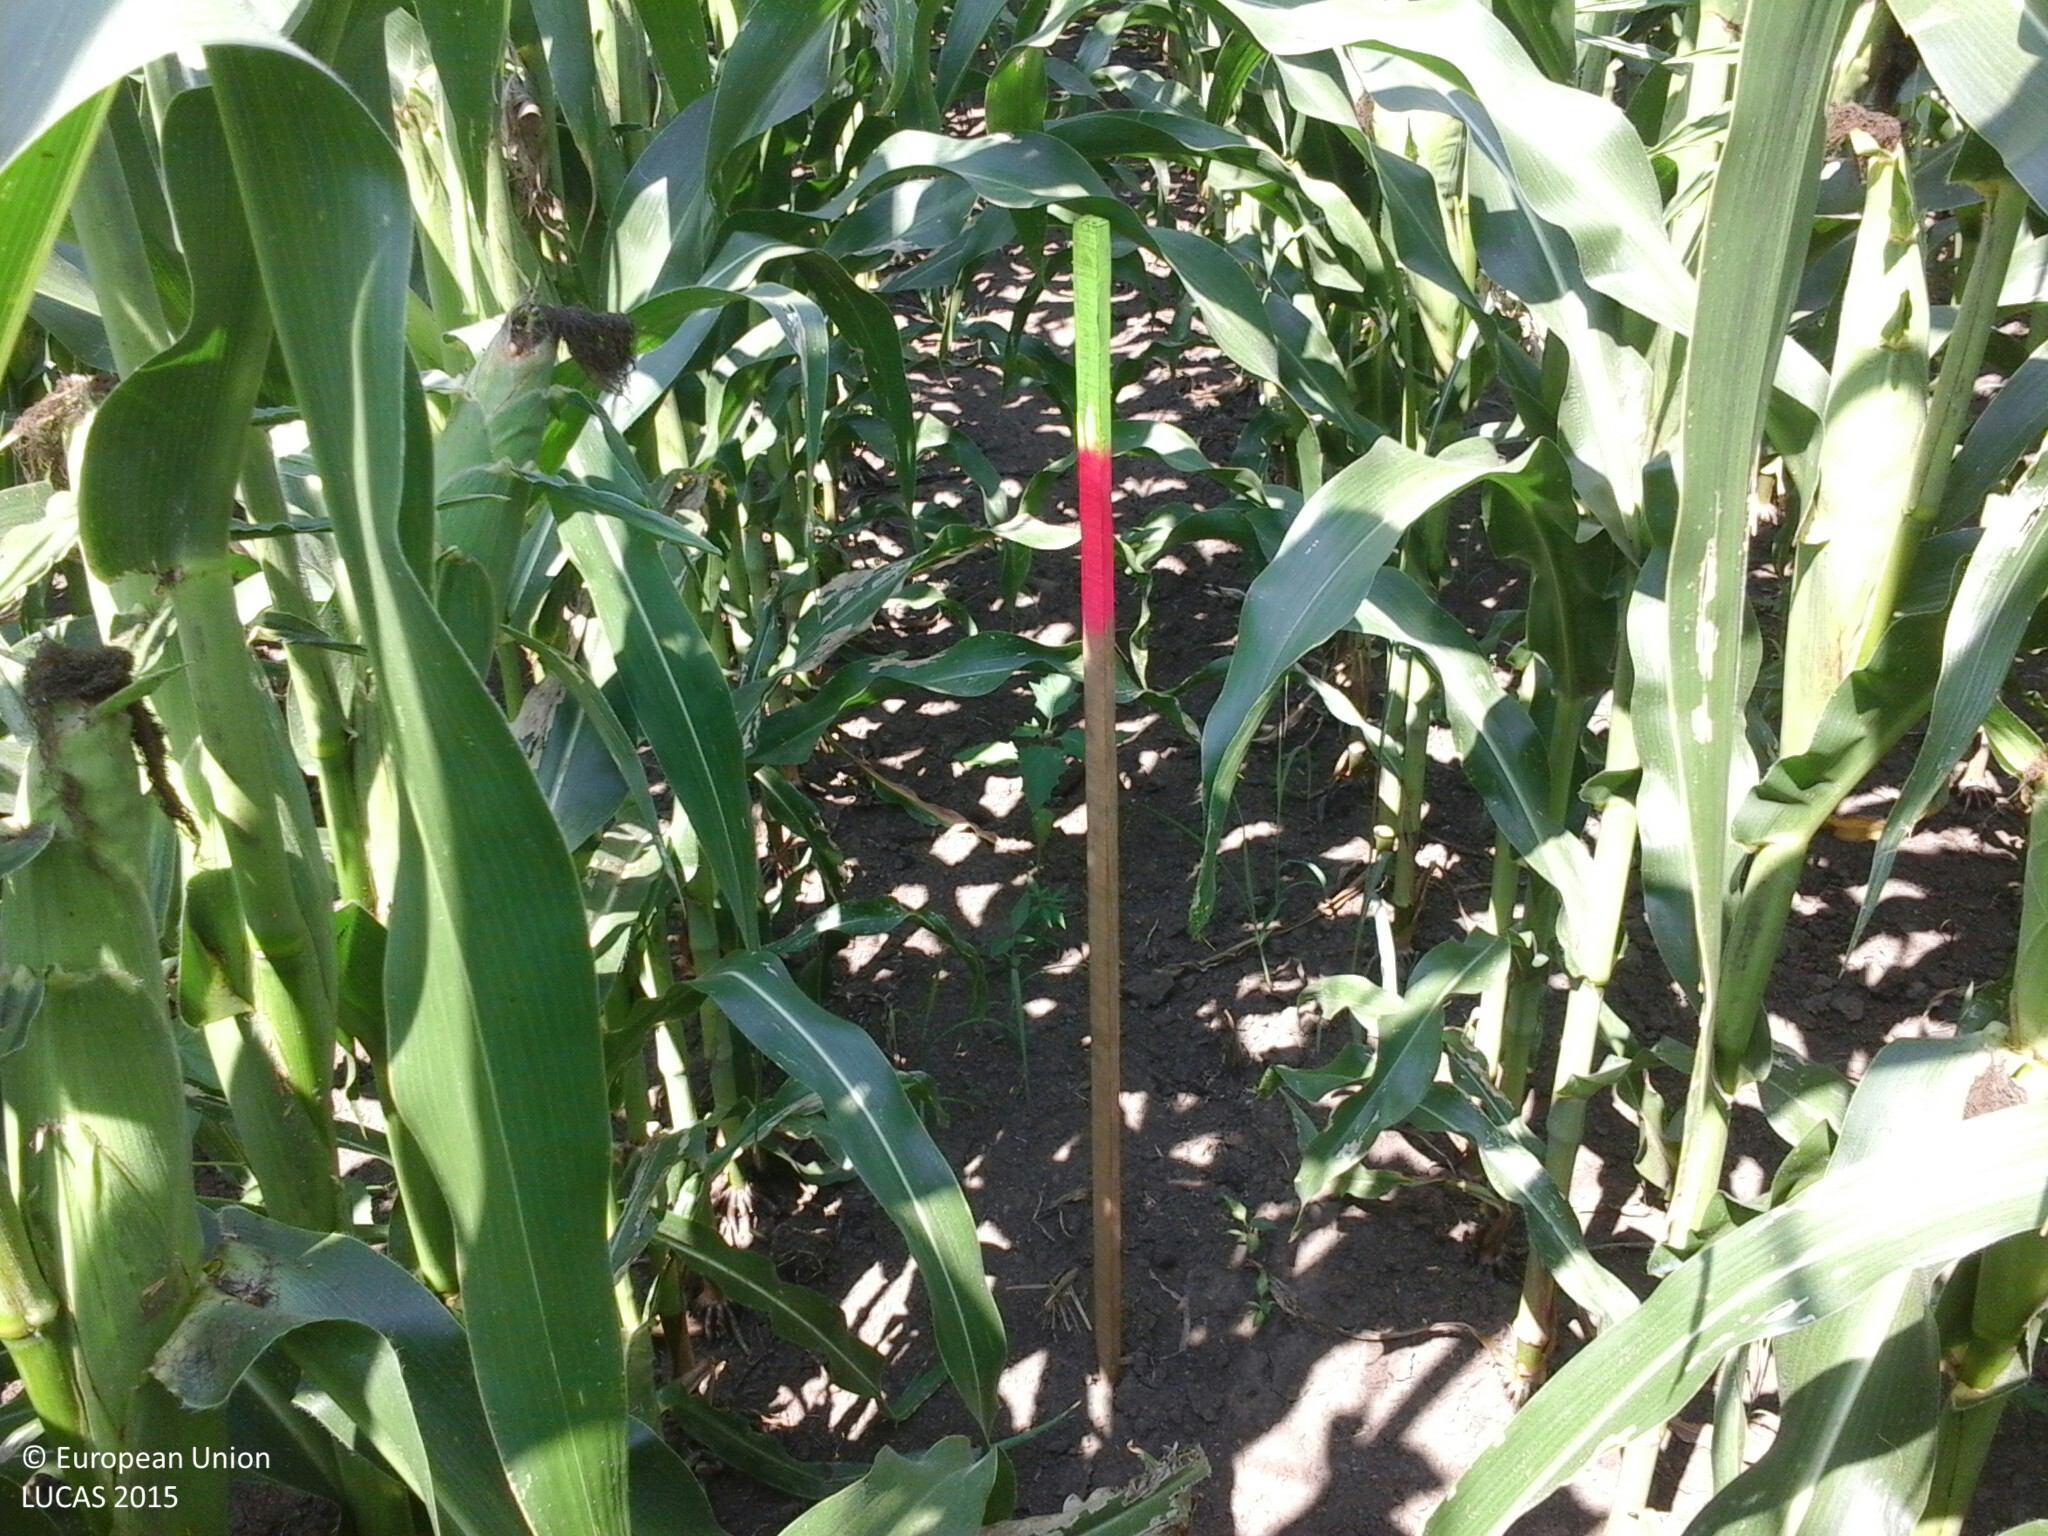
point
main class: Cropland
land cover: Maize
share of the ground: > 75 %
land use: Agriculture (excluding fallow land and kitchen gardens)
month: August
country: HU
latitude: 46.9114
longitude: 18.3481
